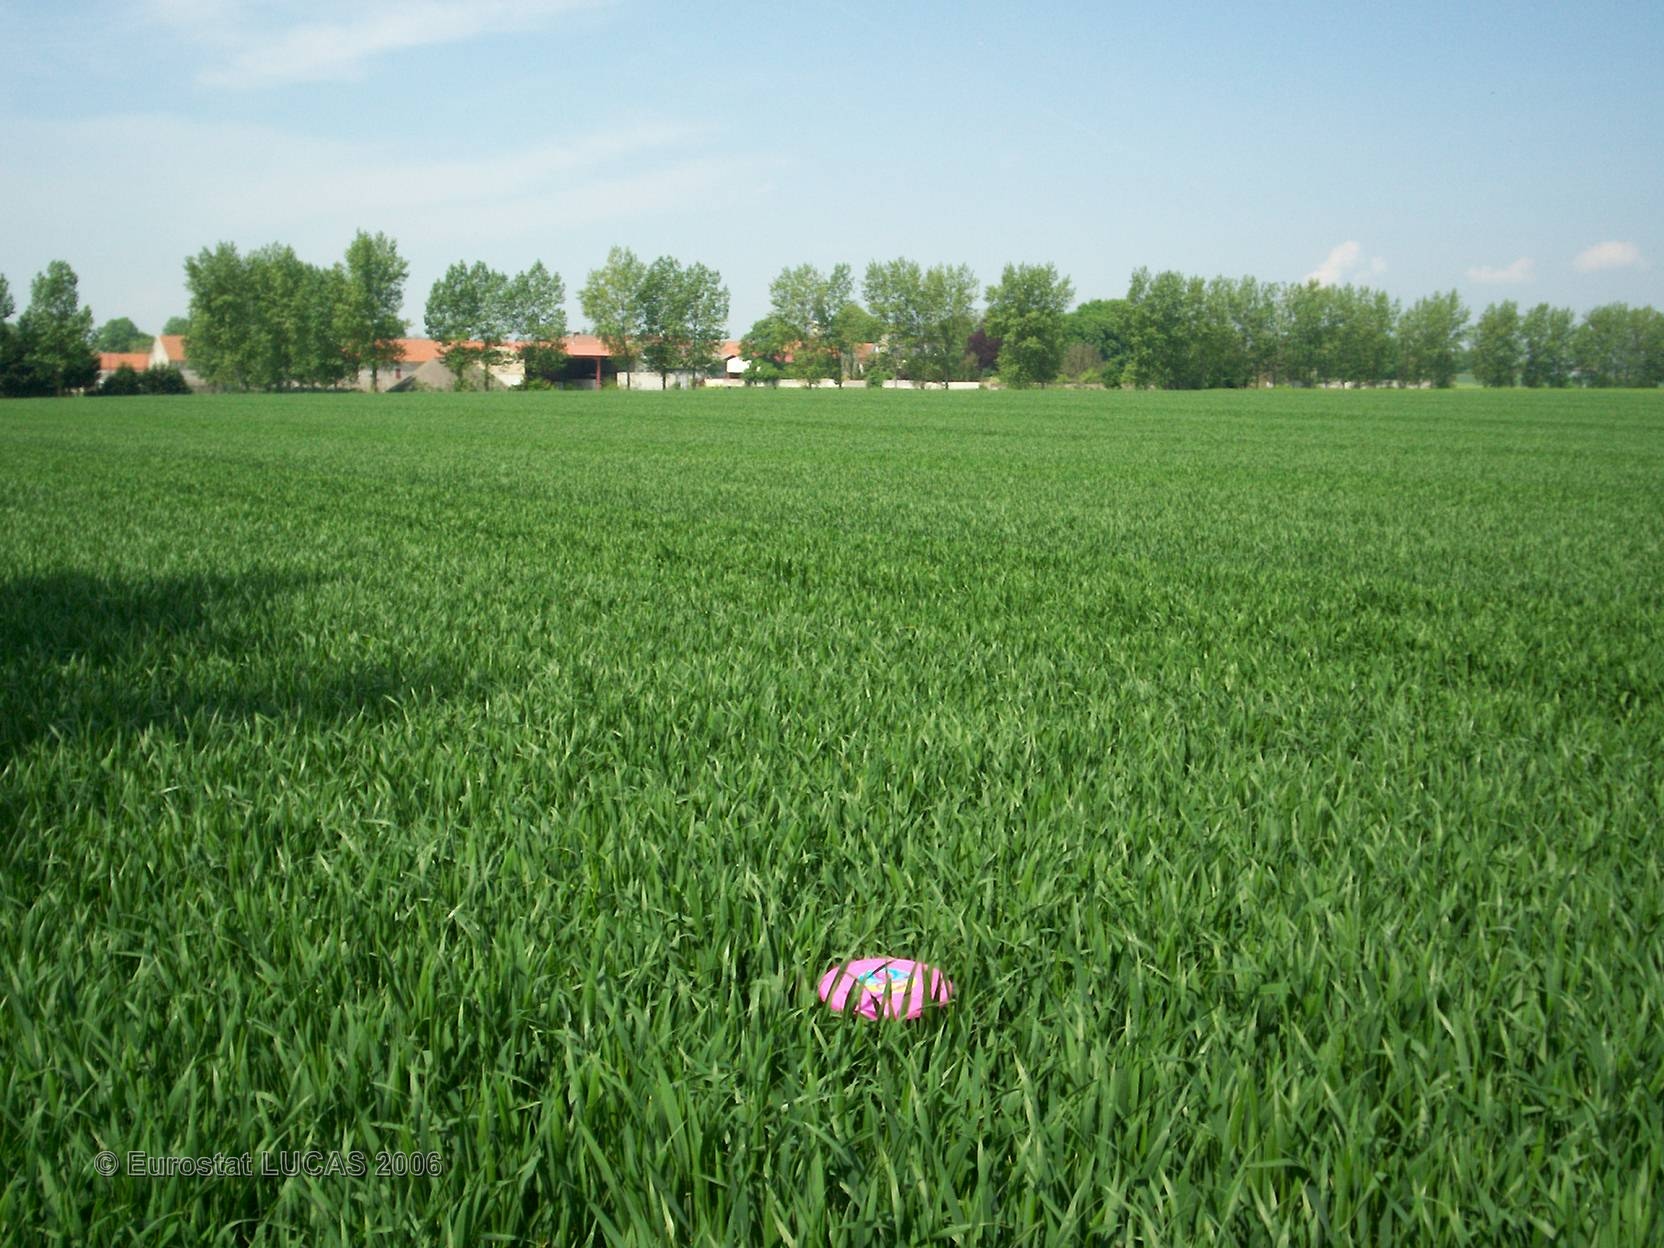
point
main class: Cropland
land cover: Common wheat
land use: Agriculture (excluding fallow land and kitchen gardens)
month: May
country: FR
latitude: 48.9807
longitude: 2.7894
